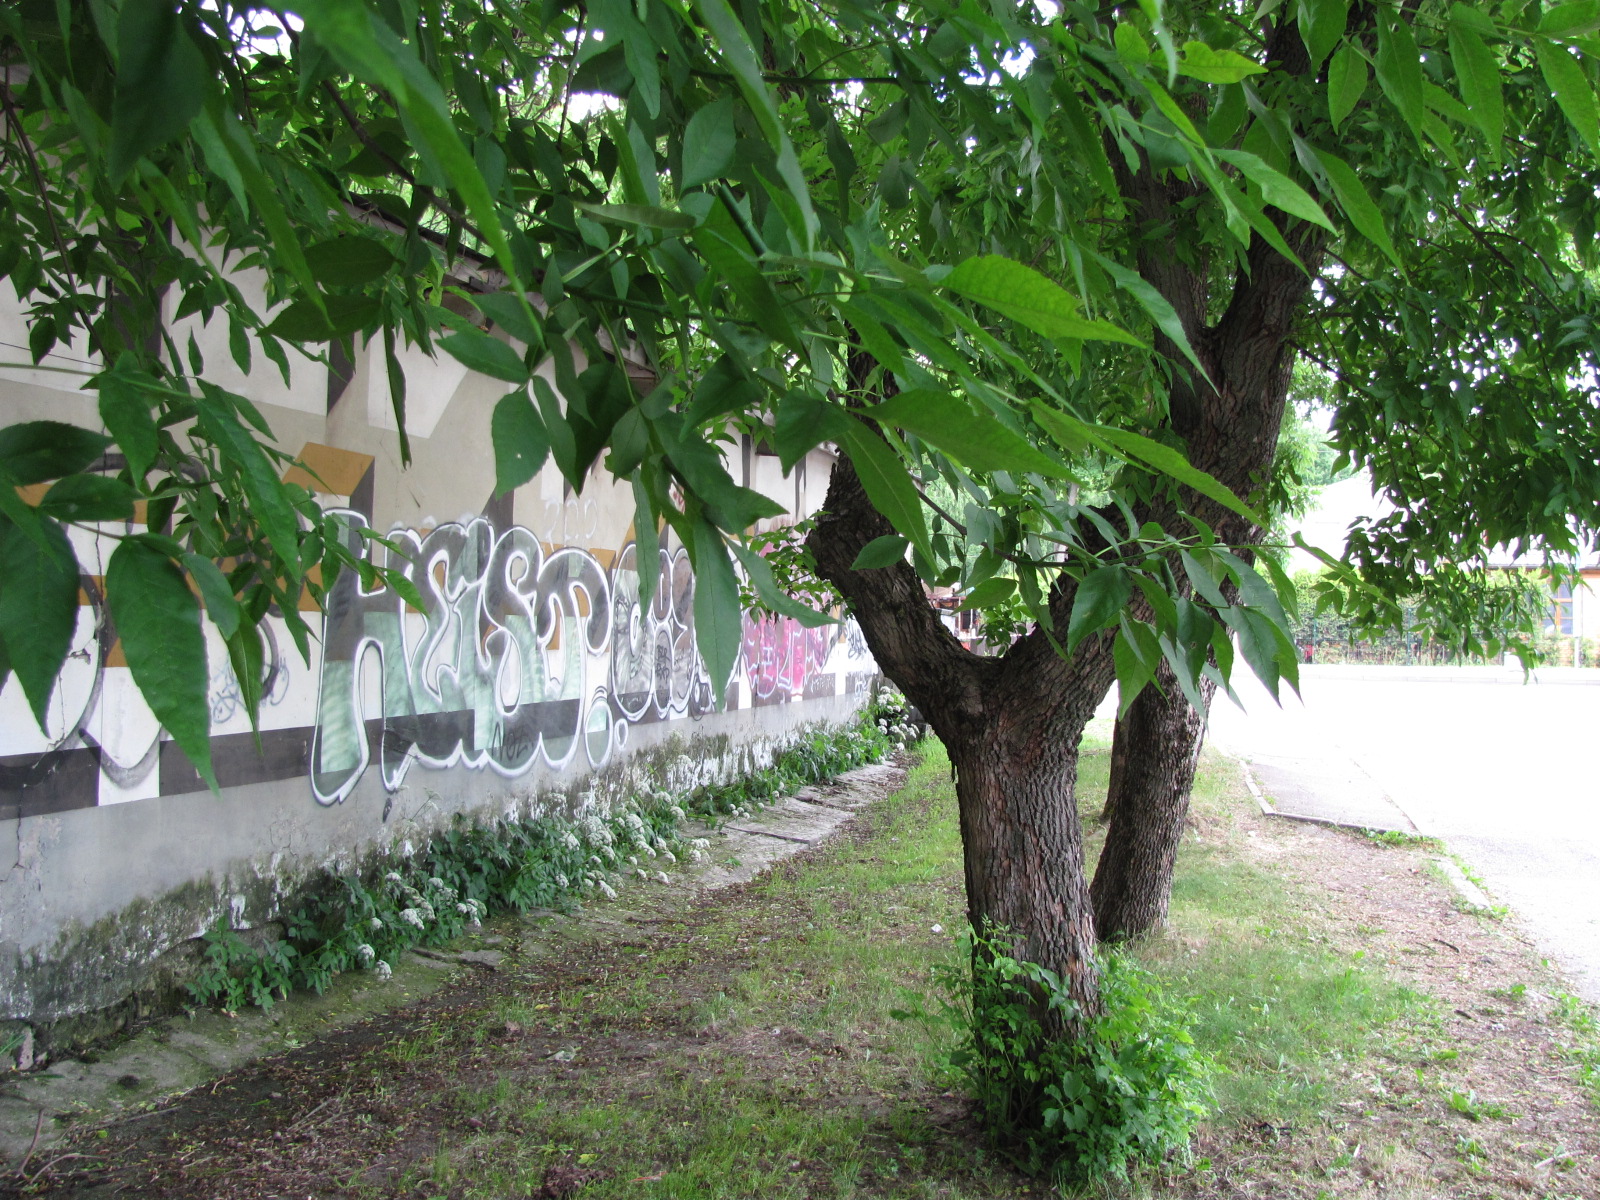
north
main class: Woodland
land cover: Broadleaved woodland
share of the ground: > 75 %
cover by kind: broadleaved forest trees 100 %
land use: Residential
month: June
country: LV
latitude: 56.9501
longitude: 24.1764
